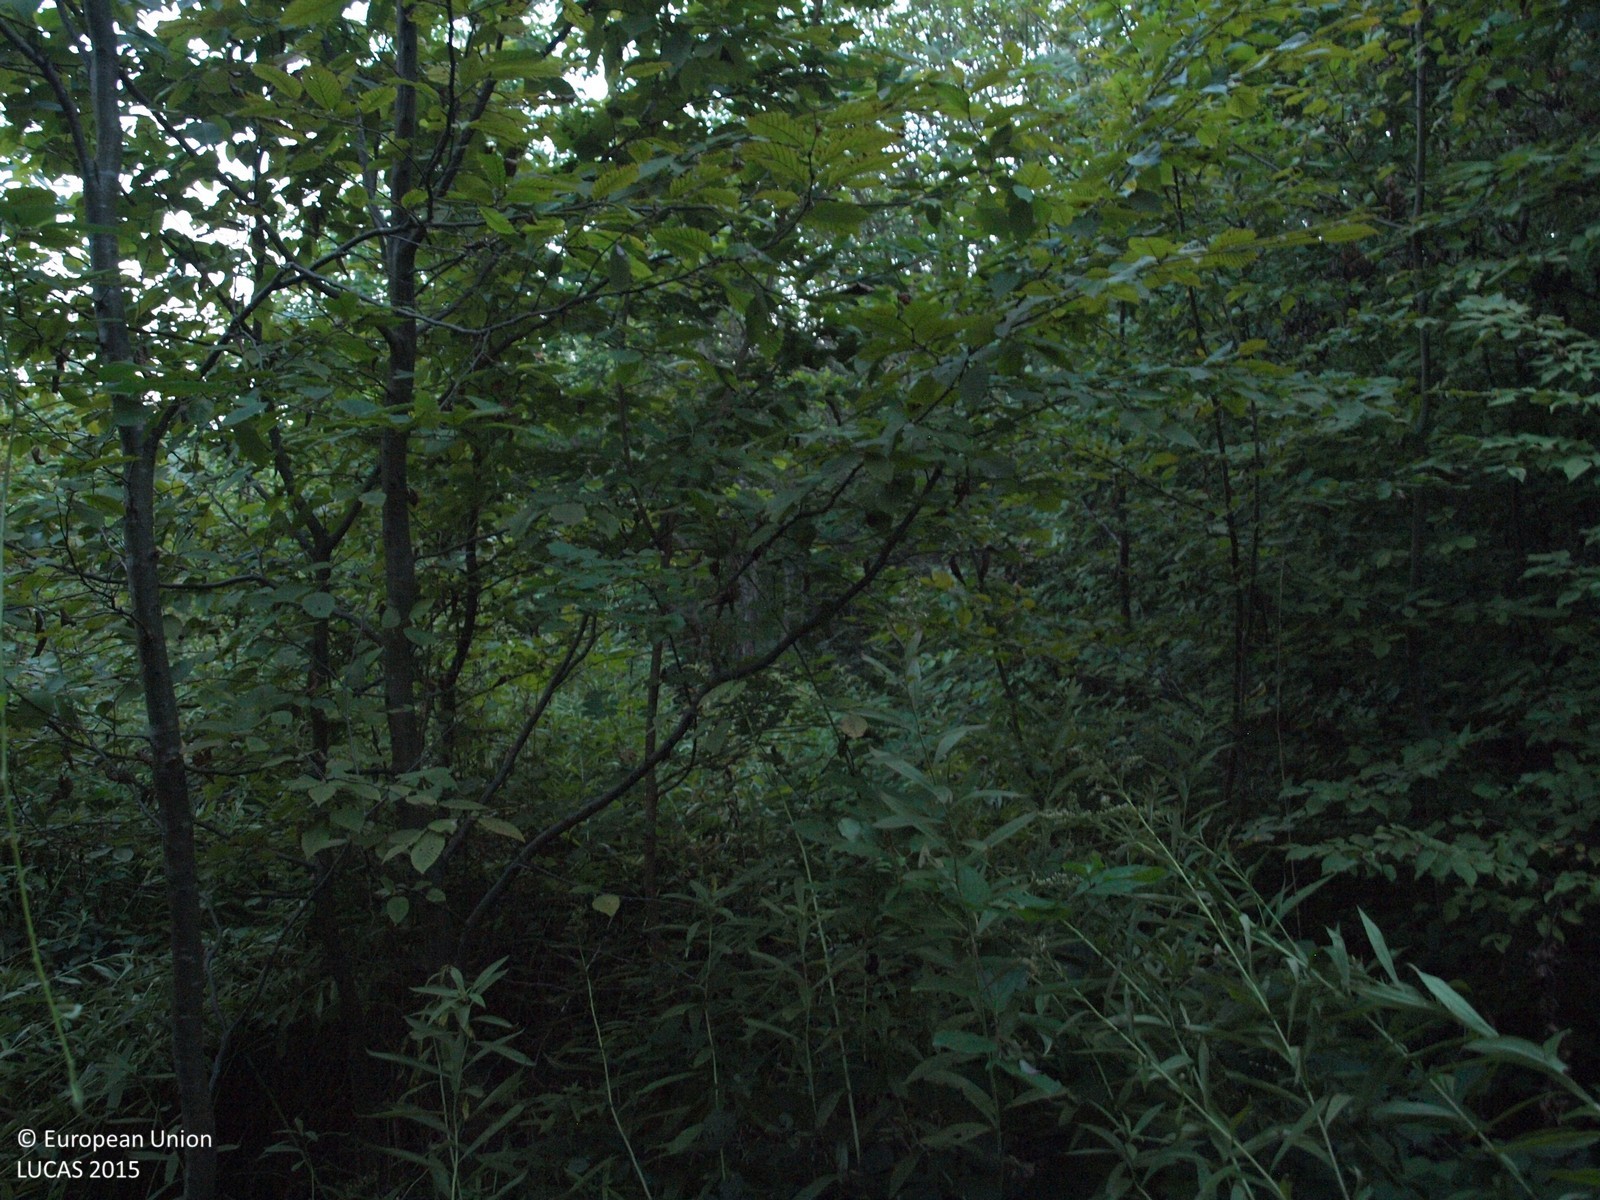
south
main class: Woodland
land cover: Broadleaved woodland
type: mesophytic deciduous forest
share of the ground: > 75 %
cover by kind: broadleaved forest trees 100 %
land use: Forestry
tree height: > 5 m
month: September
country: HR
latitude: 45.5653
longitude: 16.0576
